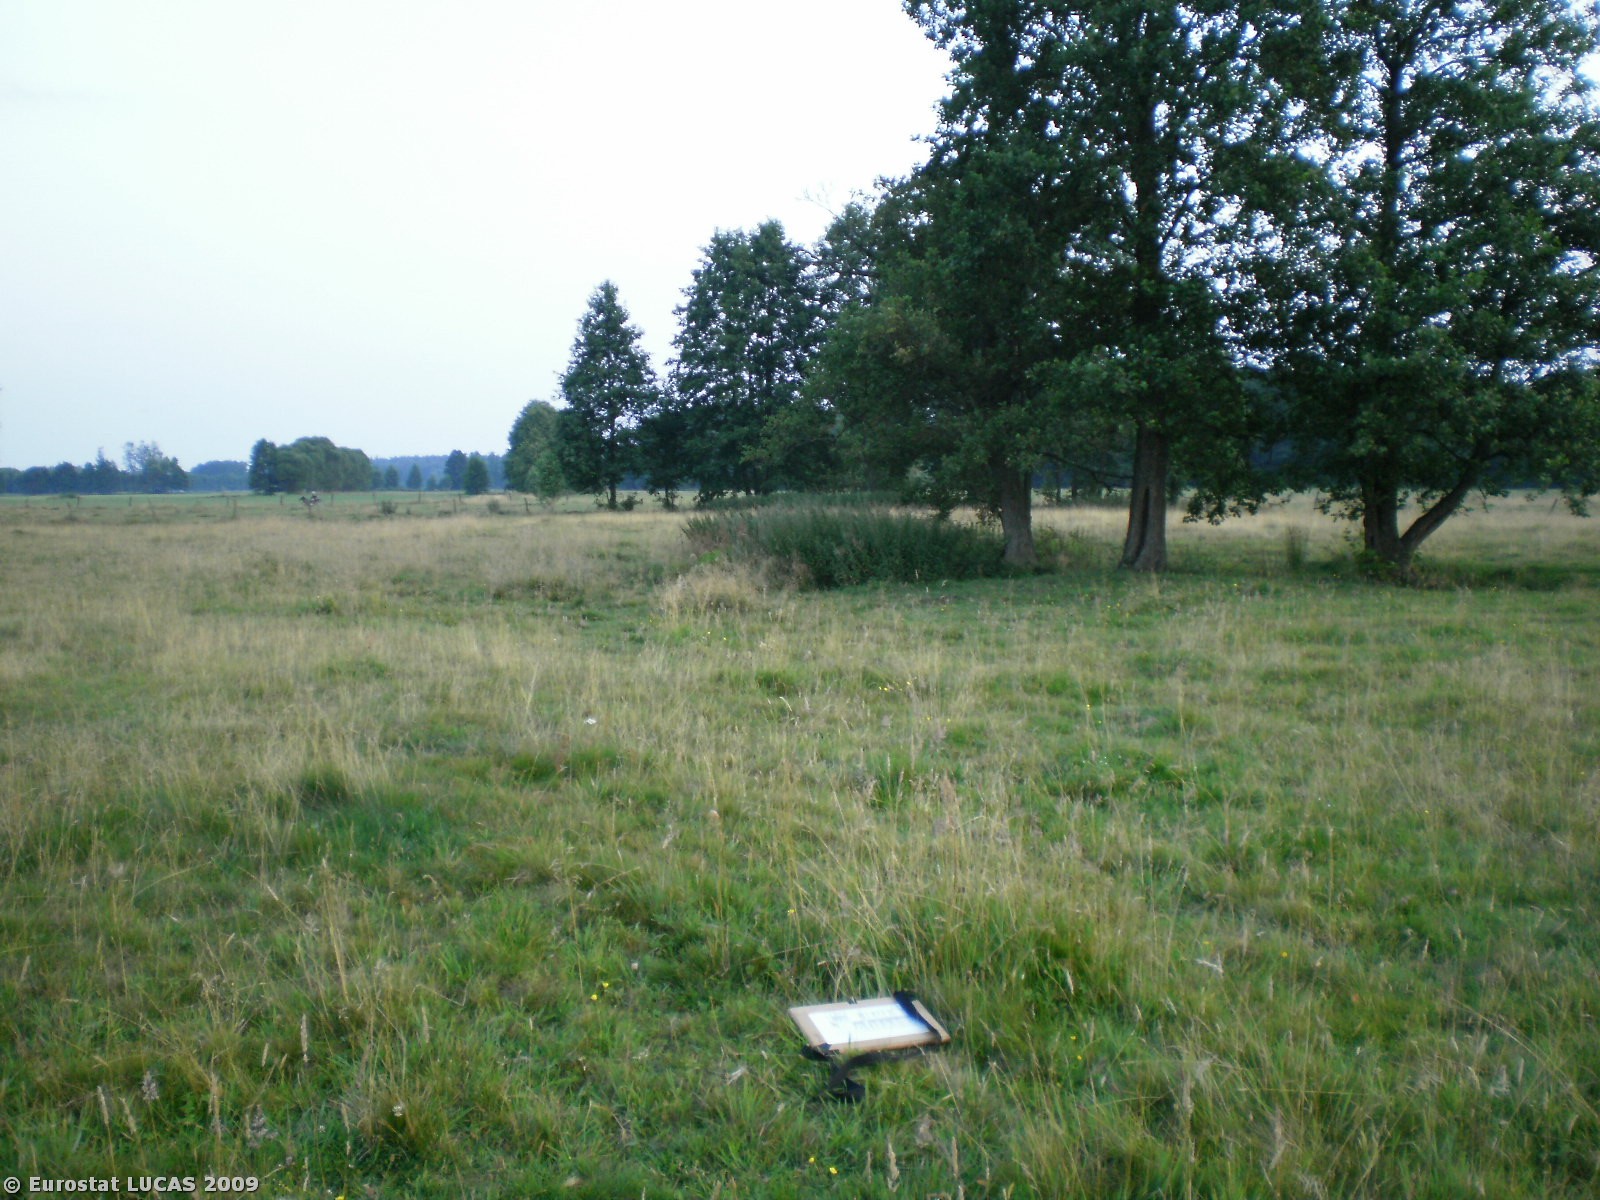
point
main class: Grassland
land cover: Grassland without tree/shrub cover
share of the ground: > 75 %
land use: Agriculture (excluding fallow land and kitchen gardens)
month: July
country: PL
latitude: 53.5129
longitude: 21.0372
